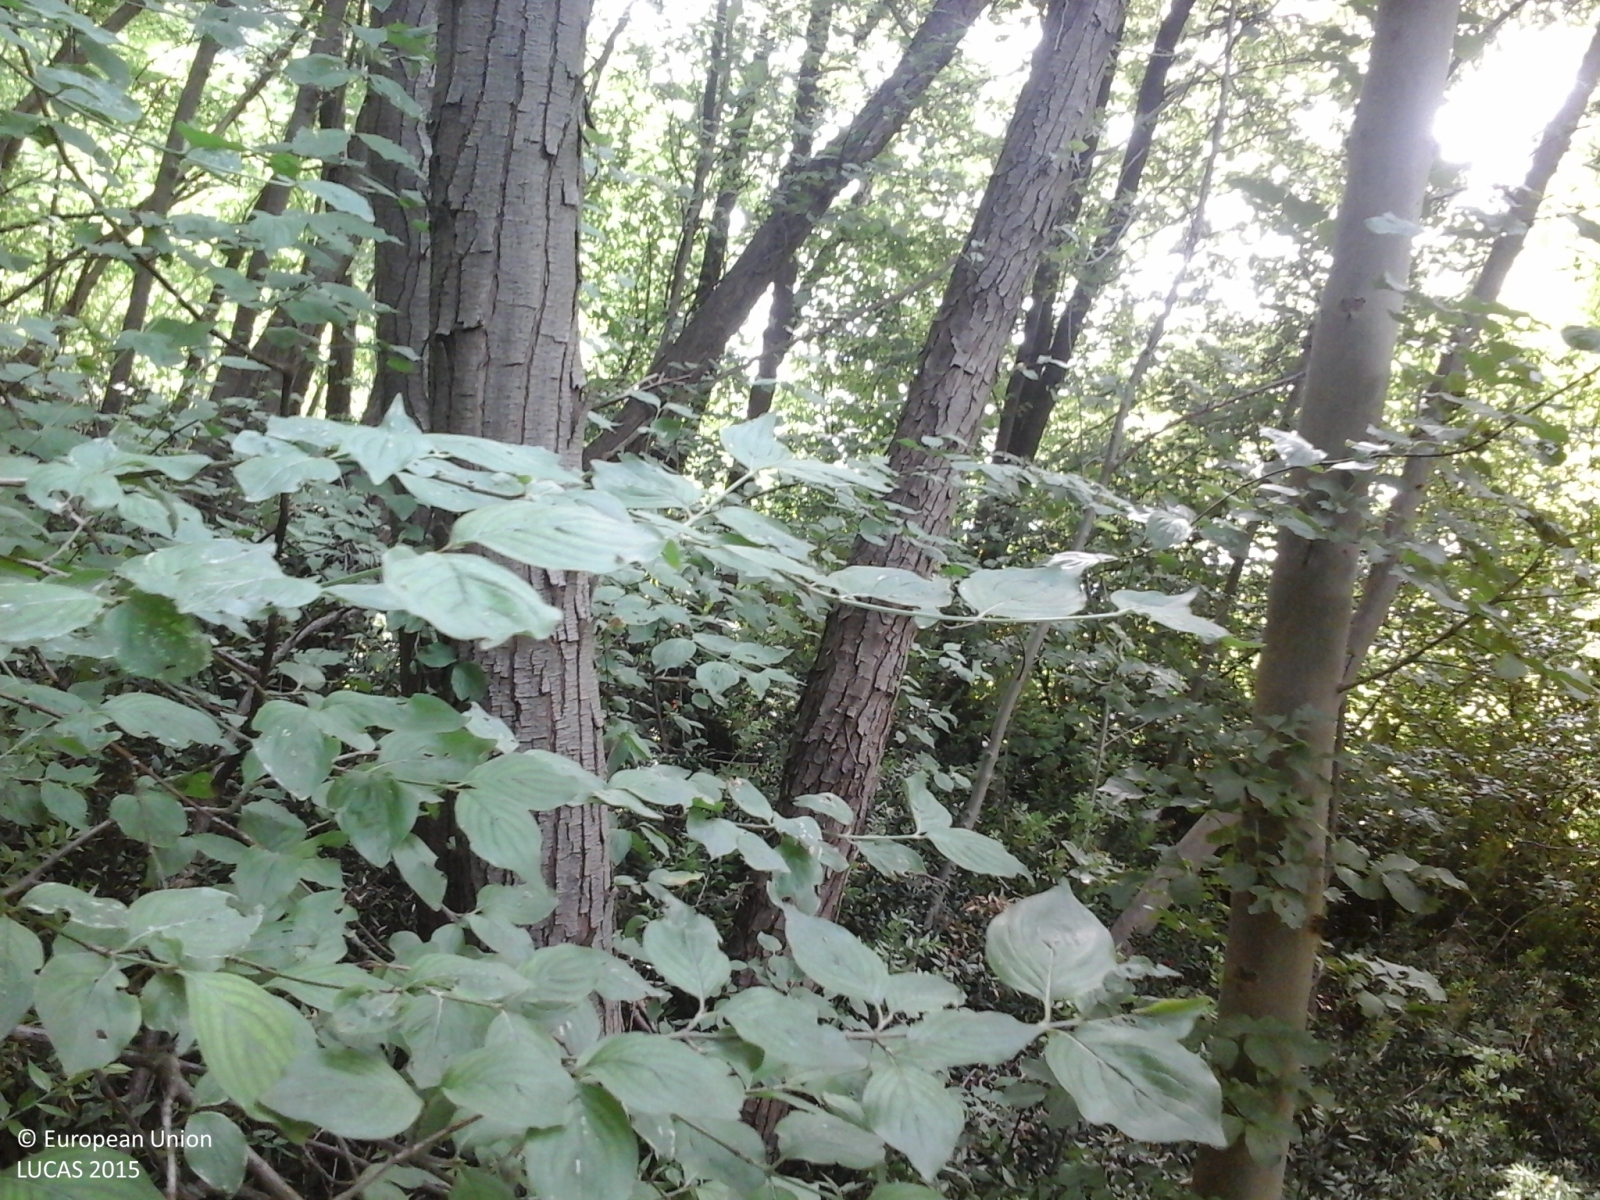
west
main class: Woodland
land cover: Broadleaved woodland
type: thermophilous deciduous forest
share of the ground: > 75 %
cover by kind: broadleaved forest trees 100 %
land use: Semi-natural and natural areas not in use
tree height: > 5 m
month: June
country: IT
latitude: 45.2925
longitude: 11.6929
